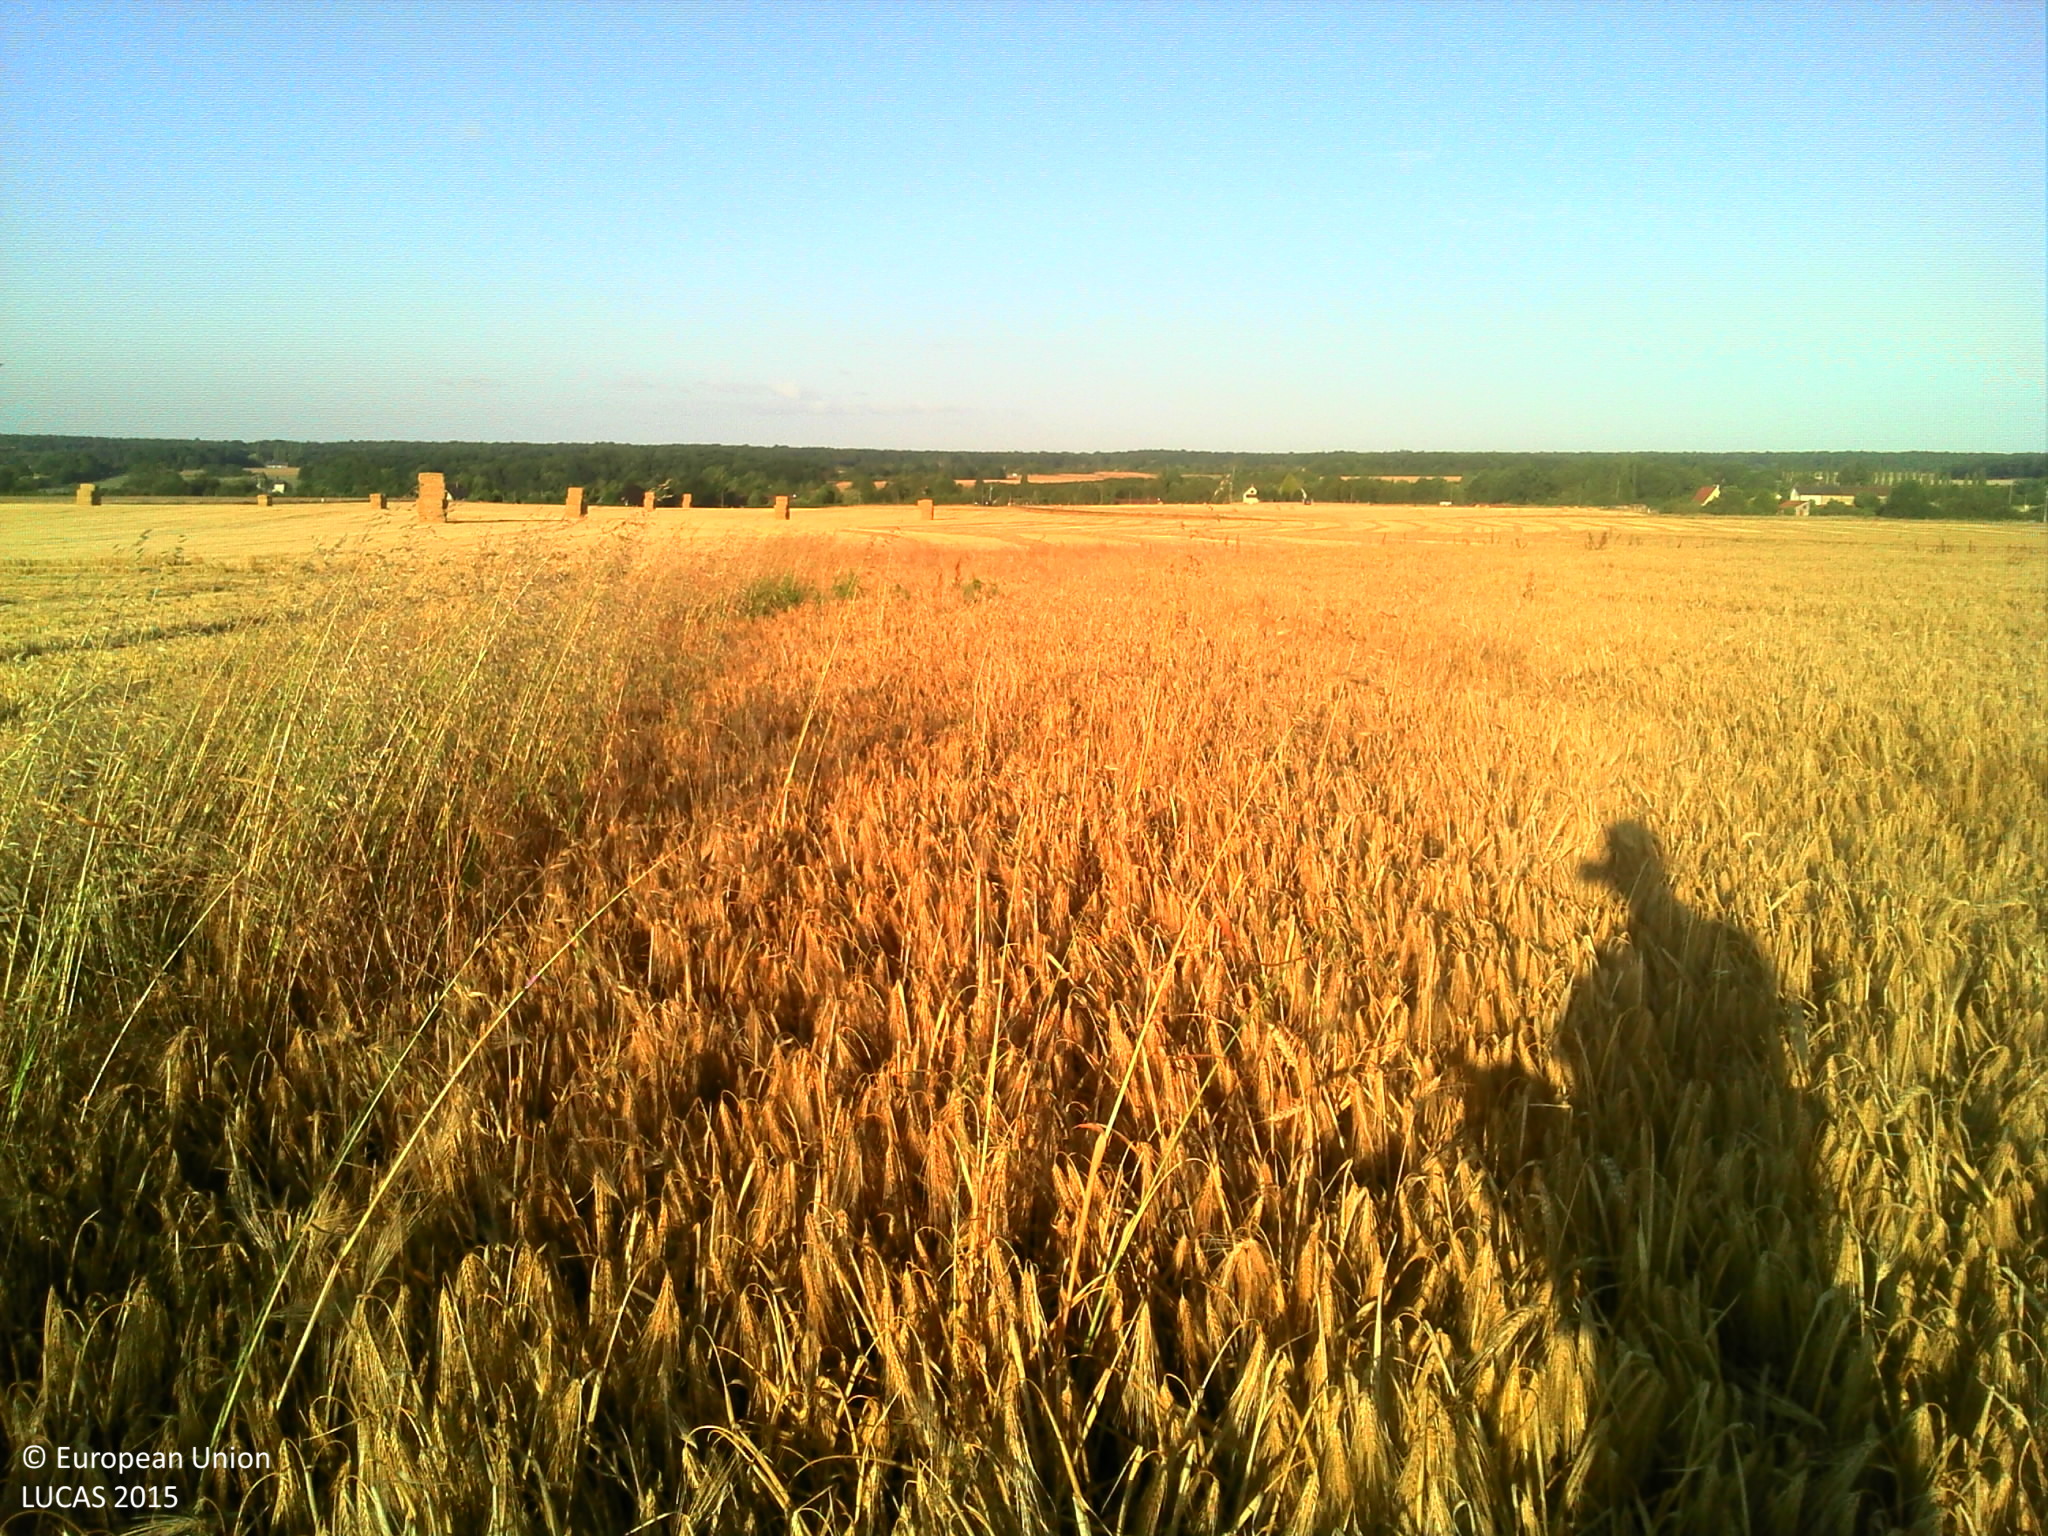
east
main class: Cropland
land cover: Barley
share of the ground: > 75 %
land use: Agriculture (excluding fallow land and kitchen gardens)
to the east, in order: Barley
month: July
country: FR
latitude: 48.8815
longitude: 0.7171
